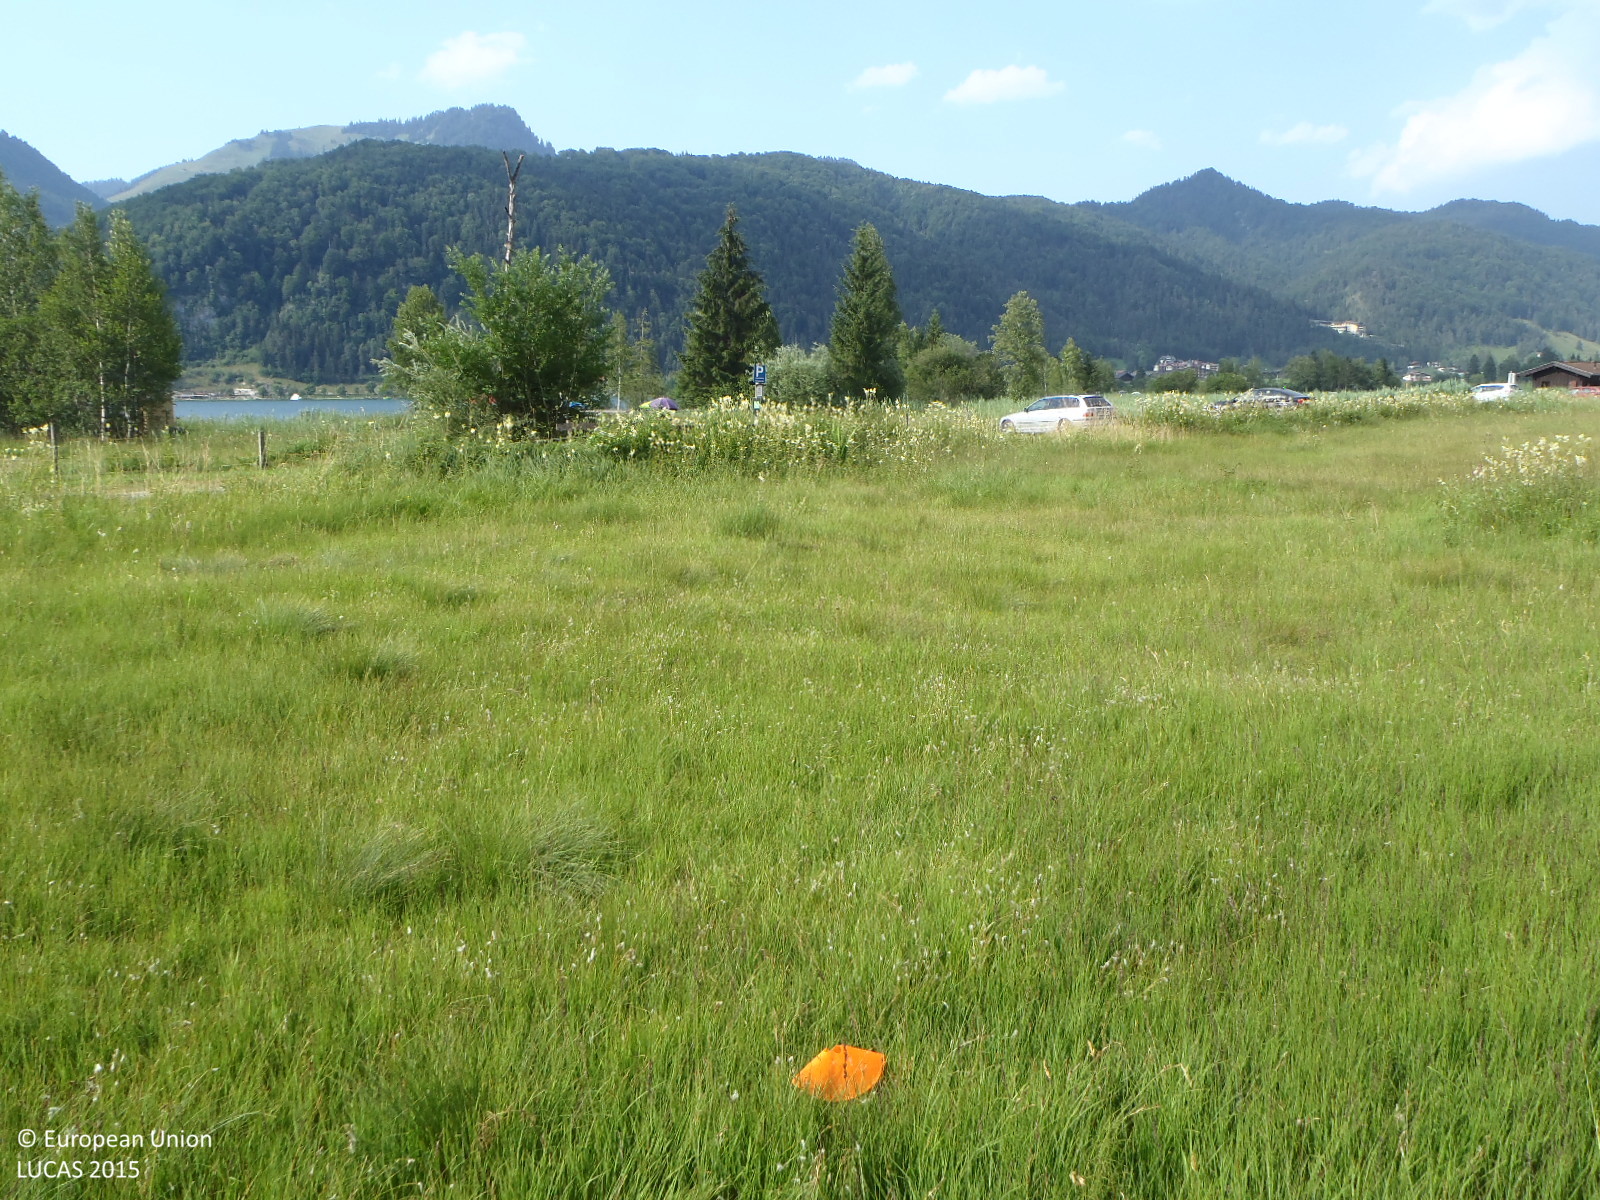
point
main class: Grassland
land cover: Grassland without tree/shrub cover
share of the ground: > 75 %
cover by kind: herbaceous plants 70 %, lichens and mosses 30 %
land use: Agriculture (excluding fallow land and kitchen gardens)
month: July
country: AT
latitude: 47.6408
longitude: 12.3279
